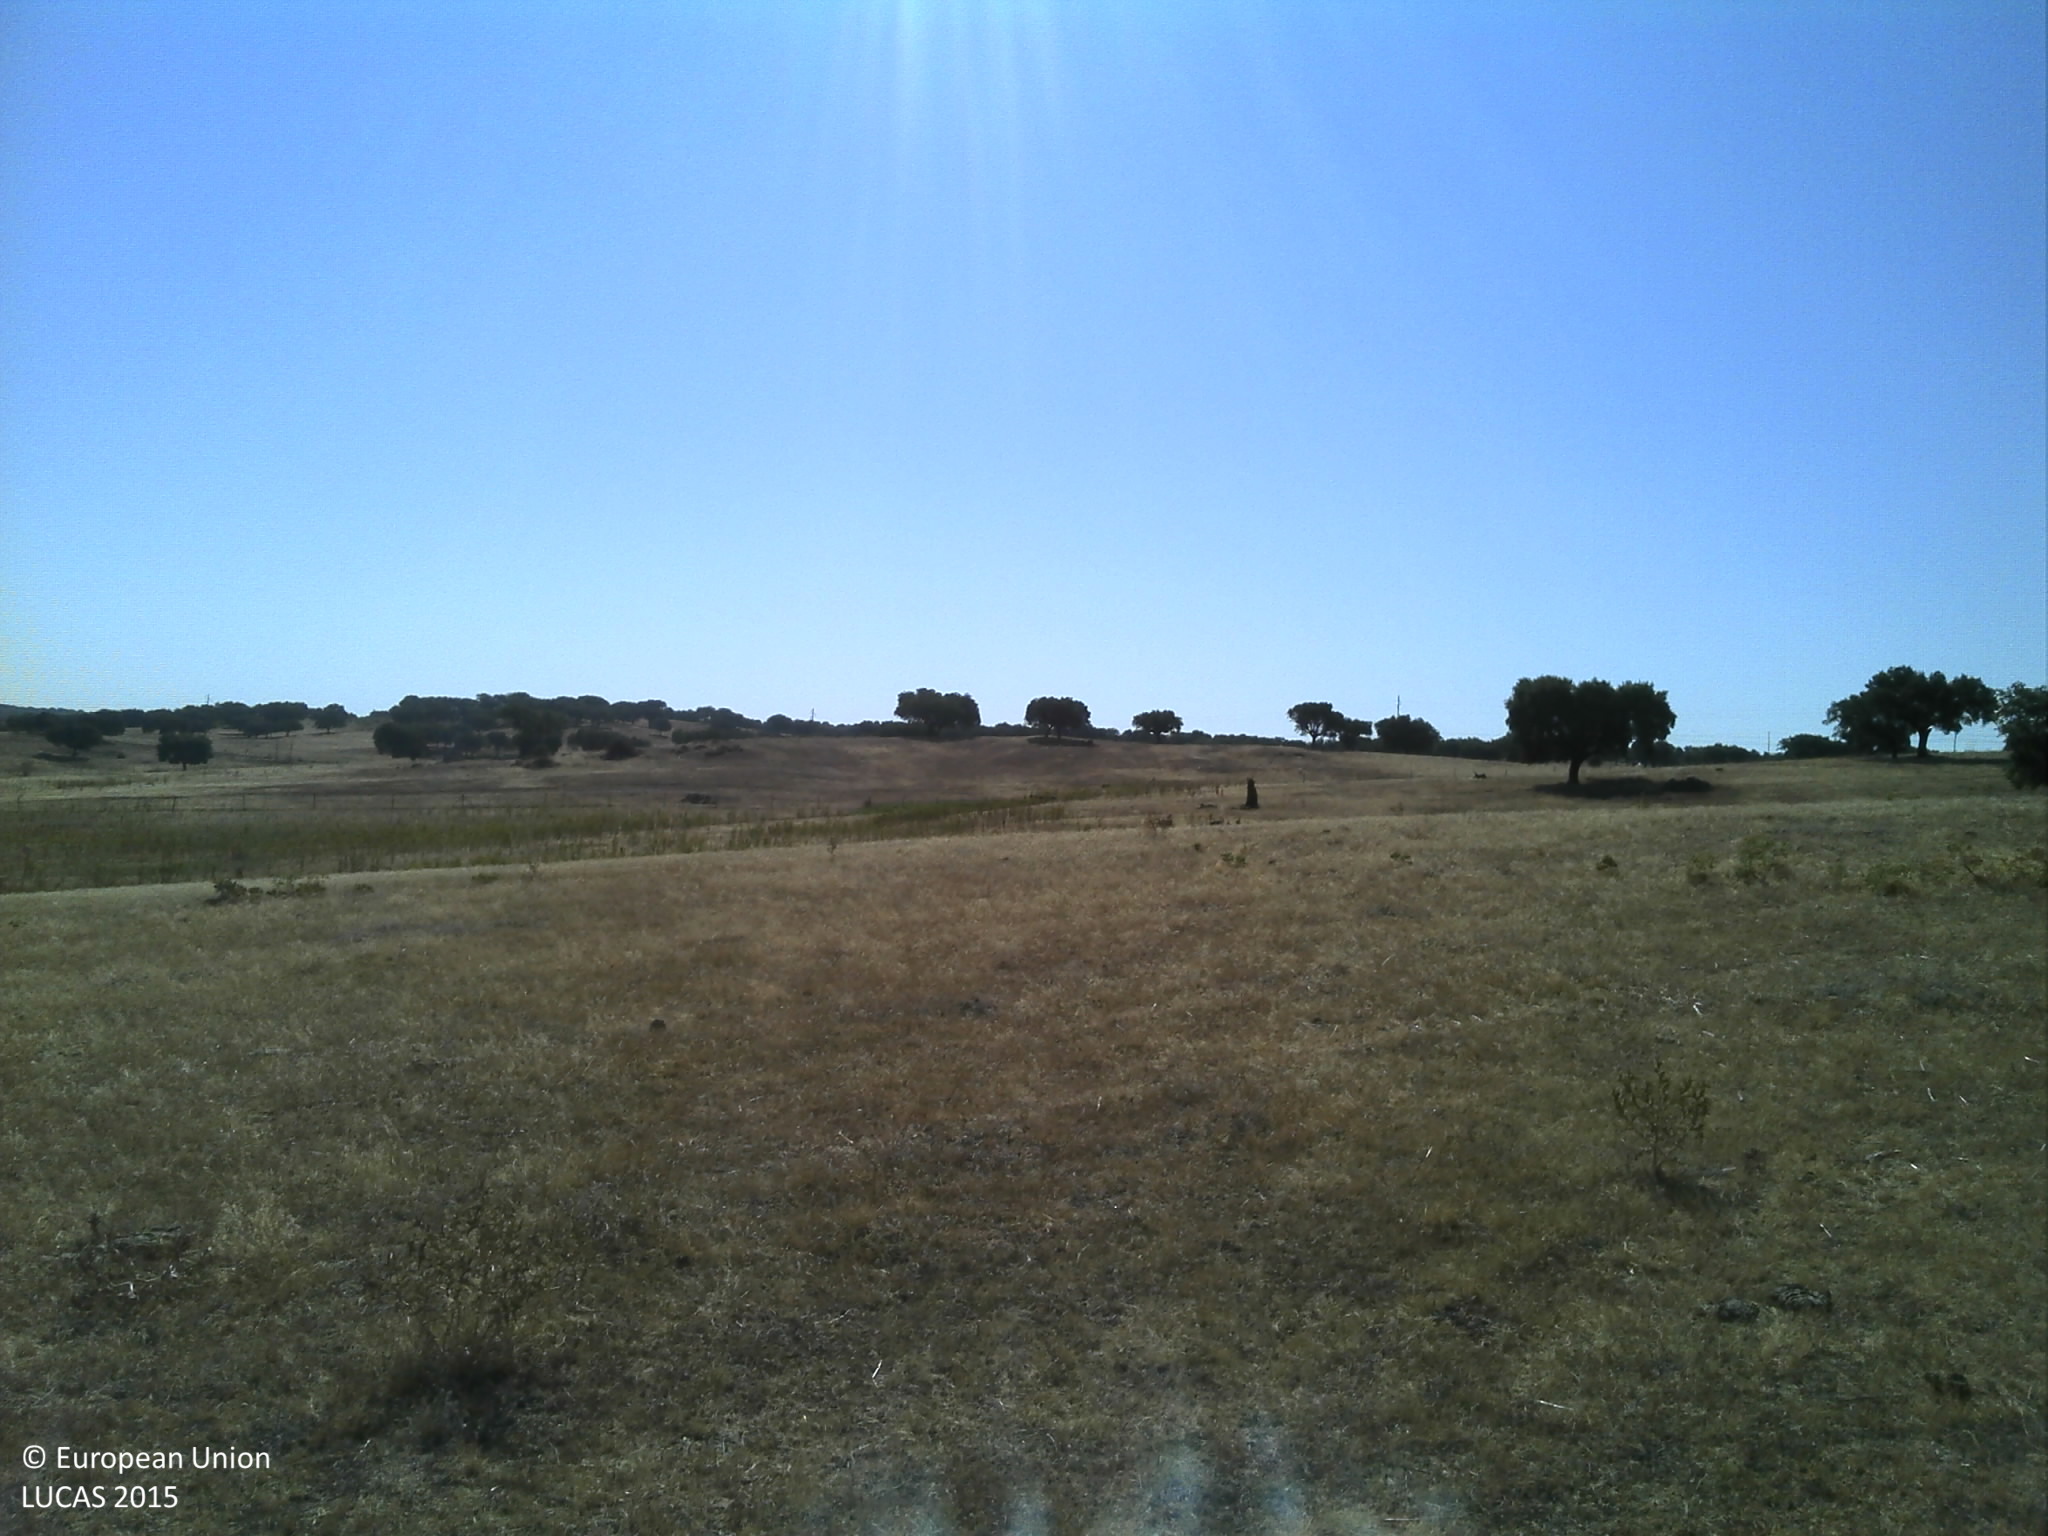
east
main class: Grassland
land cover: Grassland without tree/shrub cover
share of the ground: 25 - 50 %
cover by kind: unconsolidated bare surface 70 %, herbaceous plants 30 %
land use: Agriculture (excluding fallow land and kitchen gardens)
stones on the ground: < 10 %
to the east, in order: Grassland without tree/shrub cover; Rivers and streams; Grassland without tree/shrub cover; Rivers and streams; Grassland without tree/shrub cover; Fences; Grassland without tree/shrub cover; Rocks and stones; Grassland without tree/shrub cover; Tracks; Grassland without tree/shrub cover
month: July
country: PT
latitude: 39.0667
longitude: -7.4079
